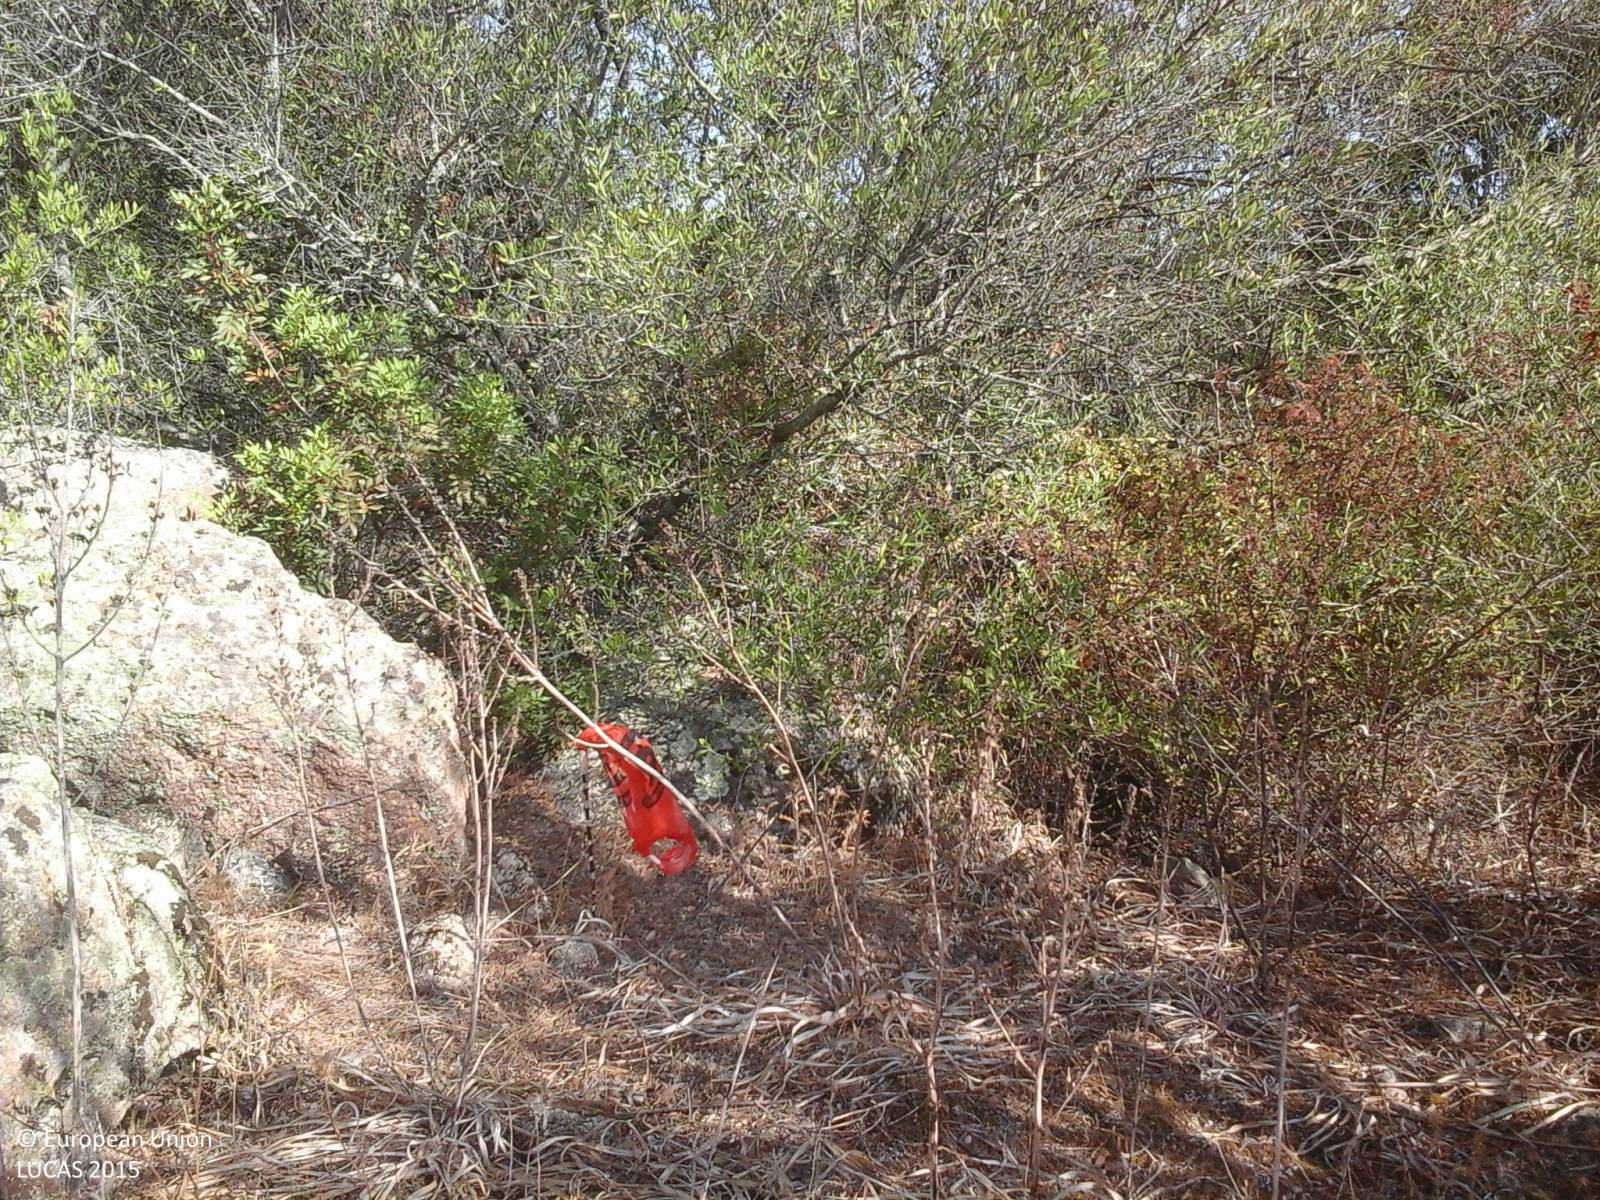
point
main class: Shrubland
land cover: Shrubland with sparse tree cover
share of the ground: > 75 %
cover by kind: shrubs 90 %, broadleaved forest trees 5 %, unconsolidated bare surface 5 %
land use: Semi-natural and natural areas not in use
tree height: > 5 m
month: September
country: IT
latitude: 41.0436
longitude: 9.3961
